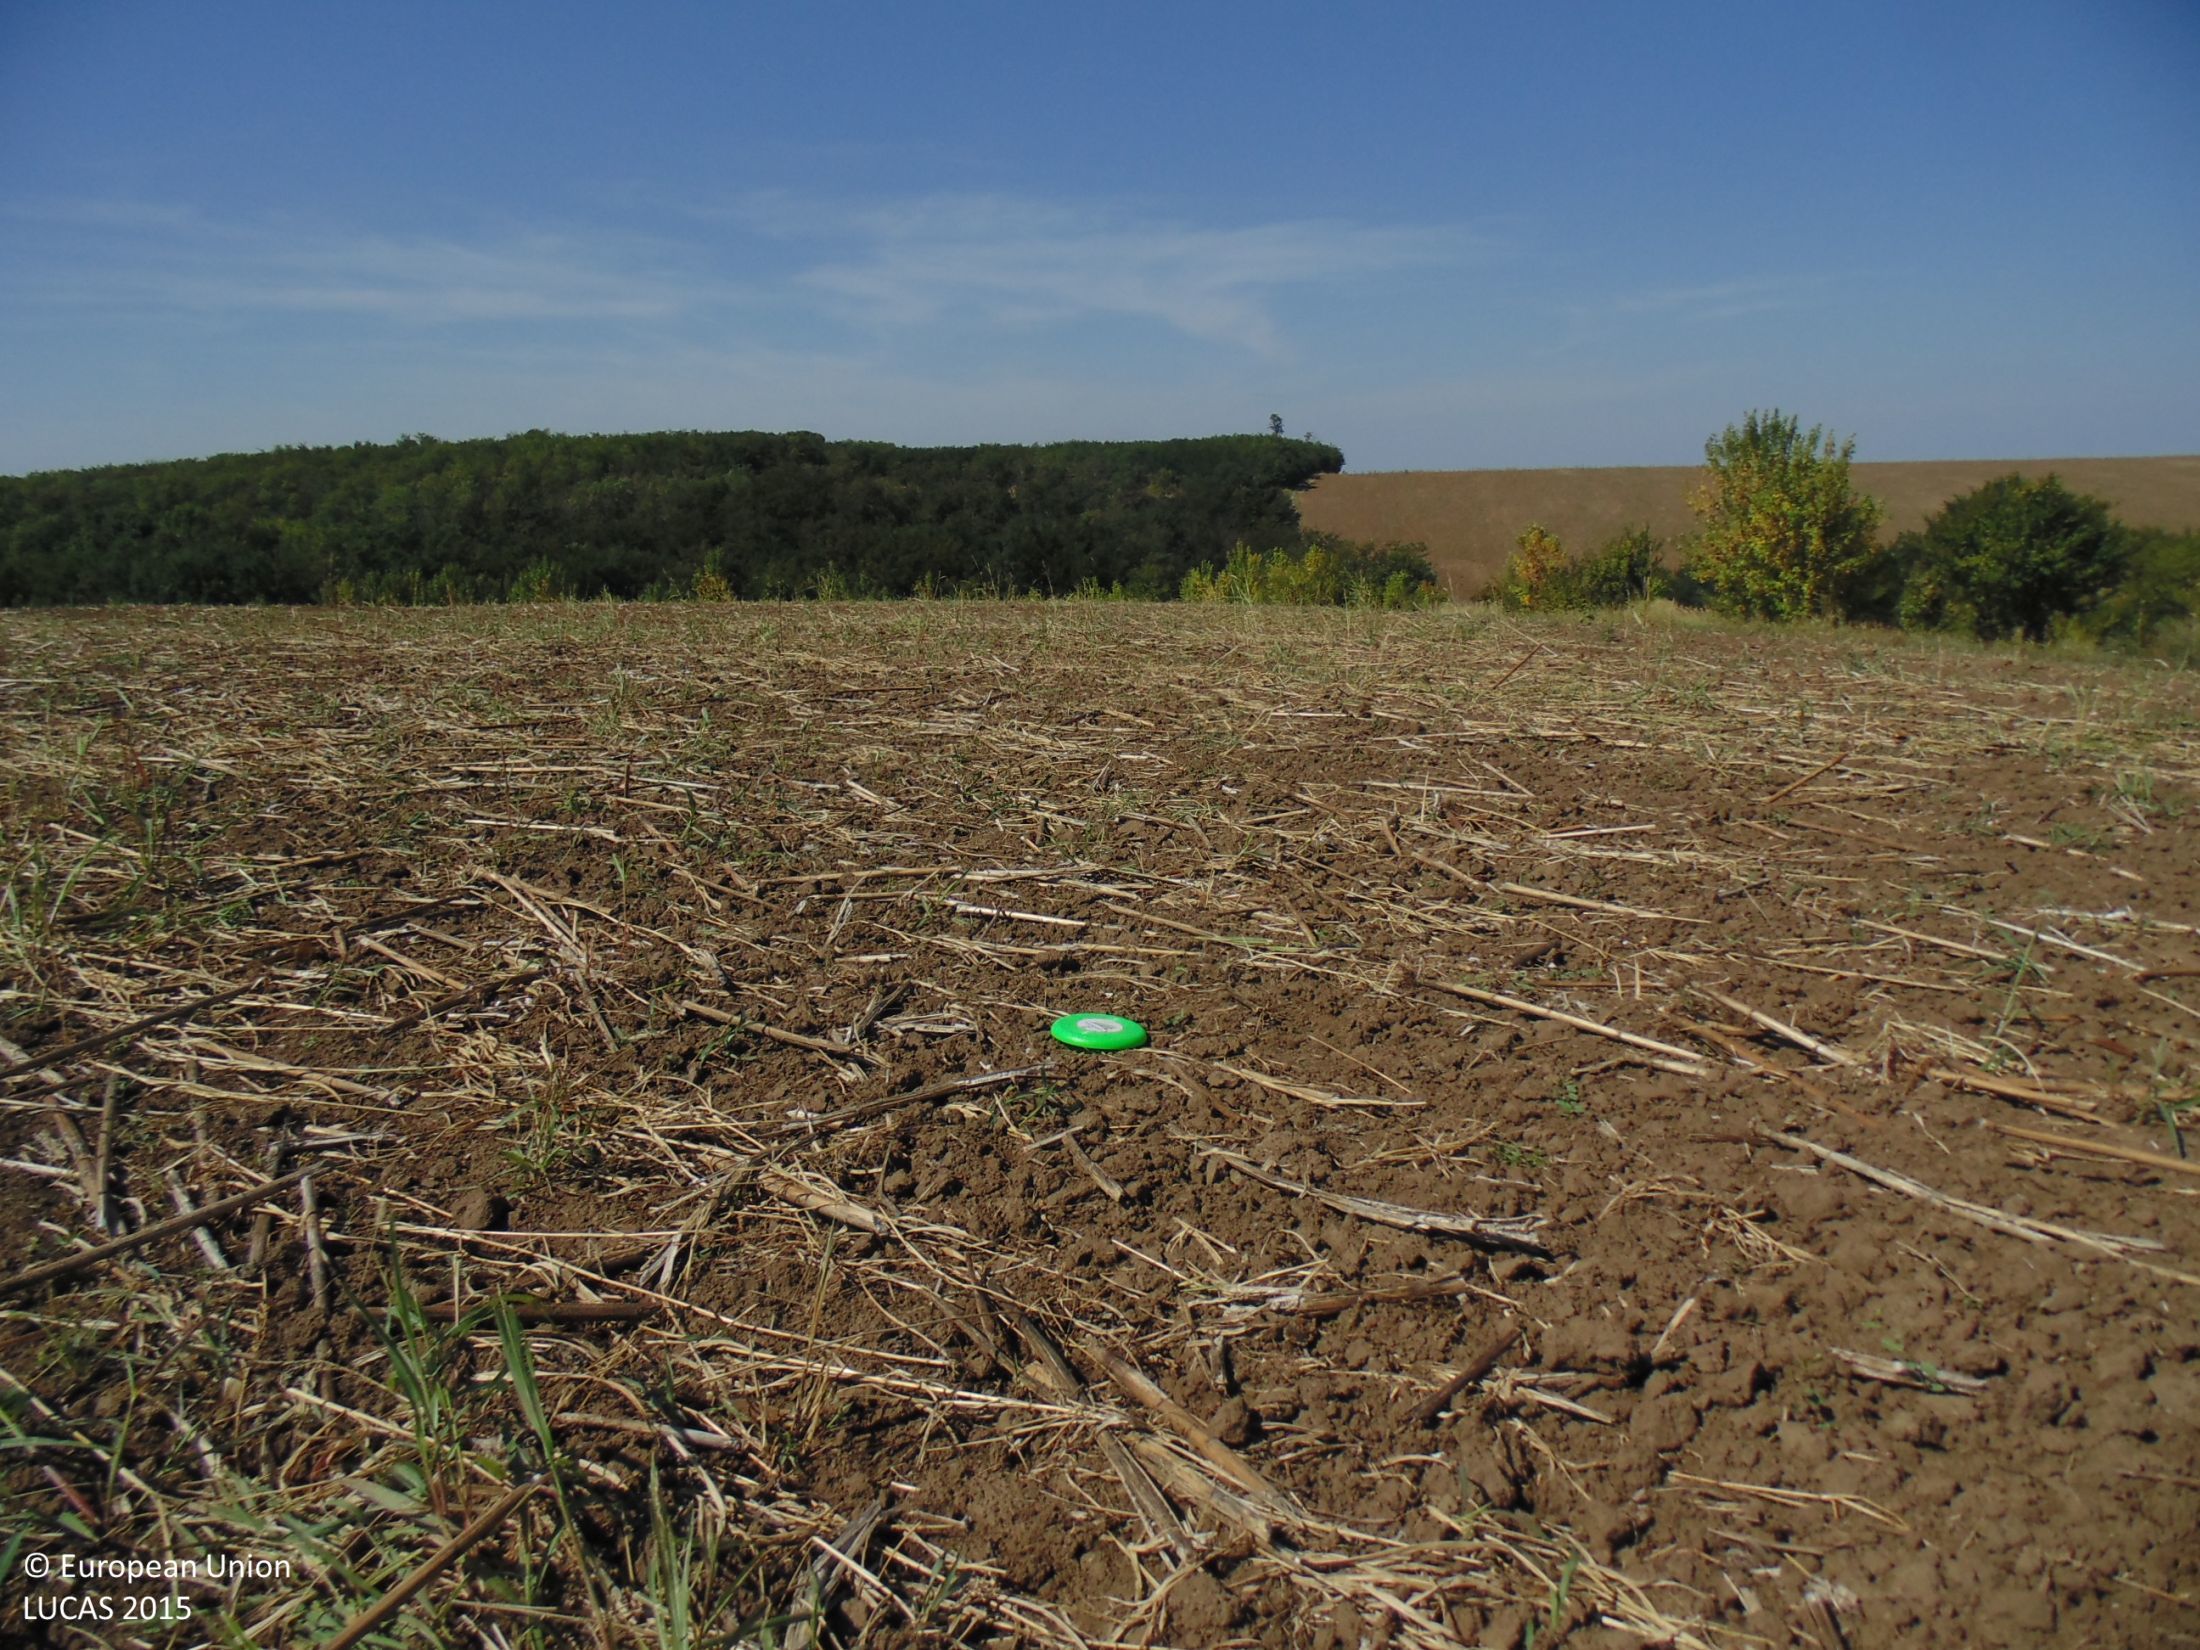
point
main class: Cropland
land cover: Sunflower
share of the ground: < 10 %
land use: Agriculture (excluding fallow land and kitchen gardens)
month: September
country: BG
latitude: 44.0852
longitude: 26.9452
